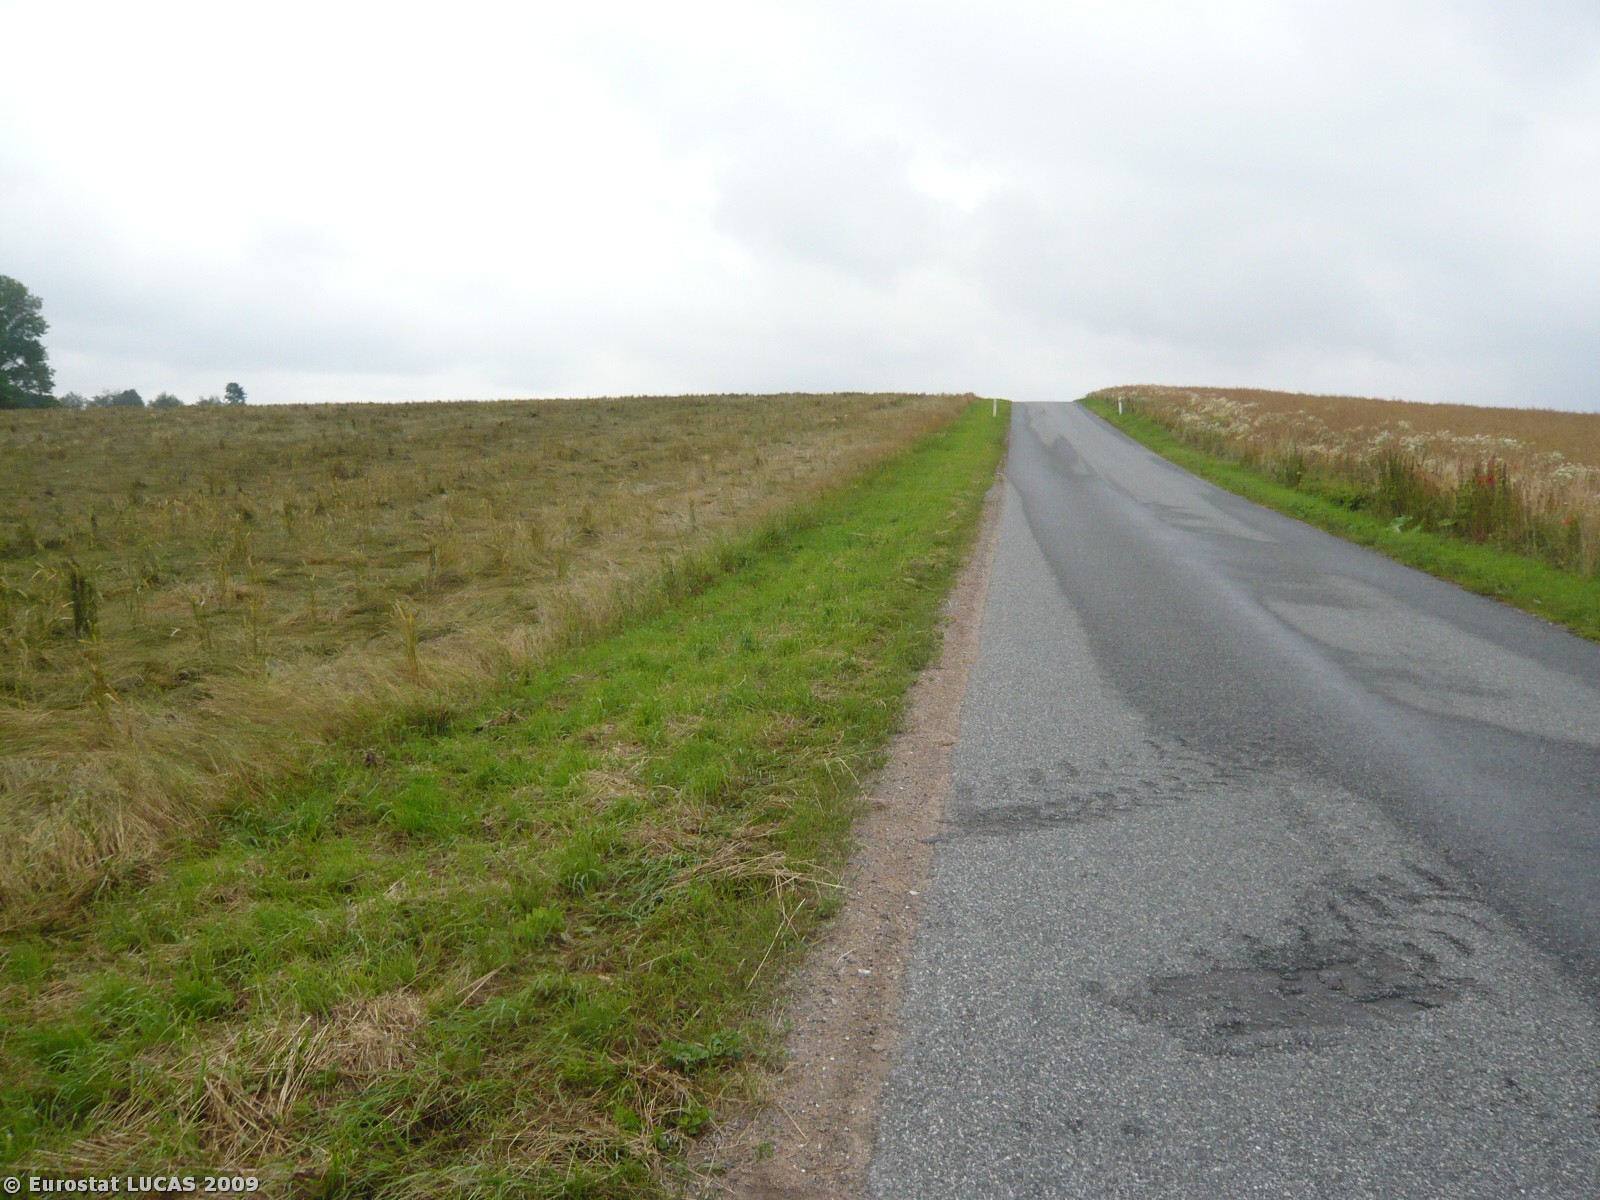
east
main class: Cropland
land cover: Rape and turnip rape
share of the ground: > 75 %
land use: Agriculture (excluding fallow land and kitchen gardens)
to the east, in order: Rape and turnip rape; Common wheat
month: July
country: DK
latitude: 55.7423
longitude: 11.8938
